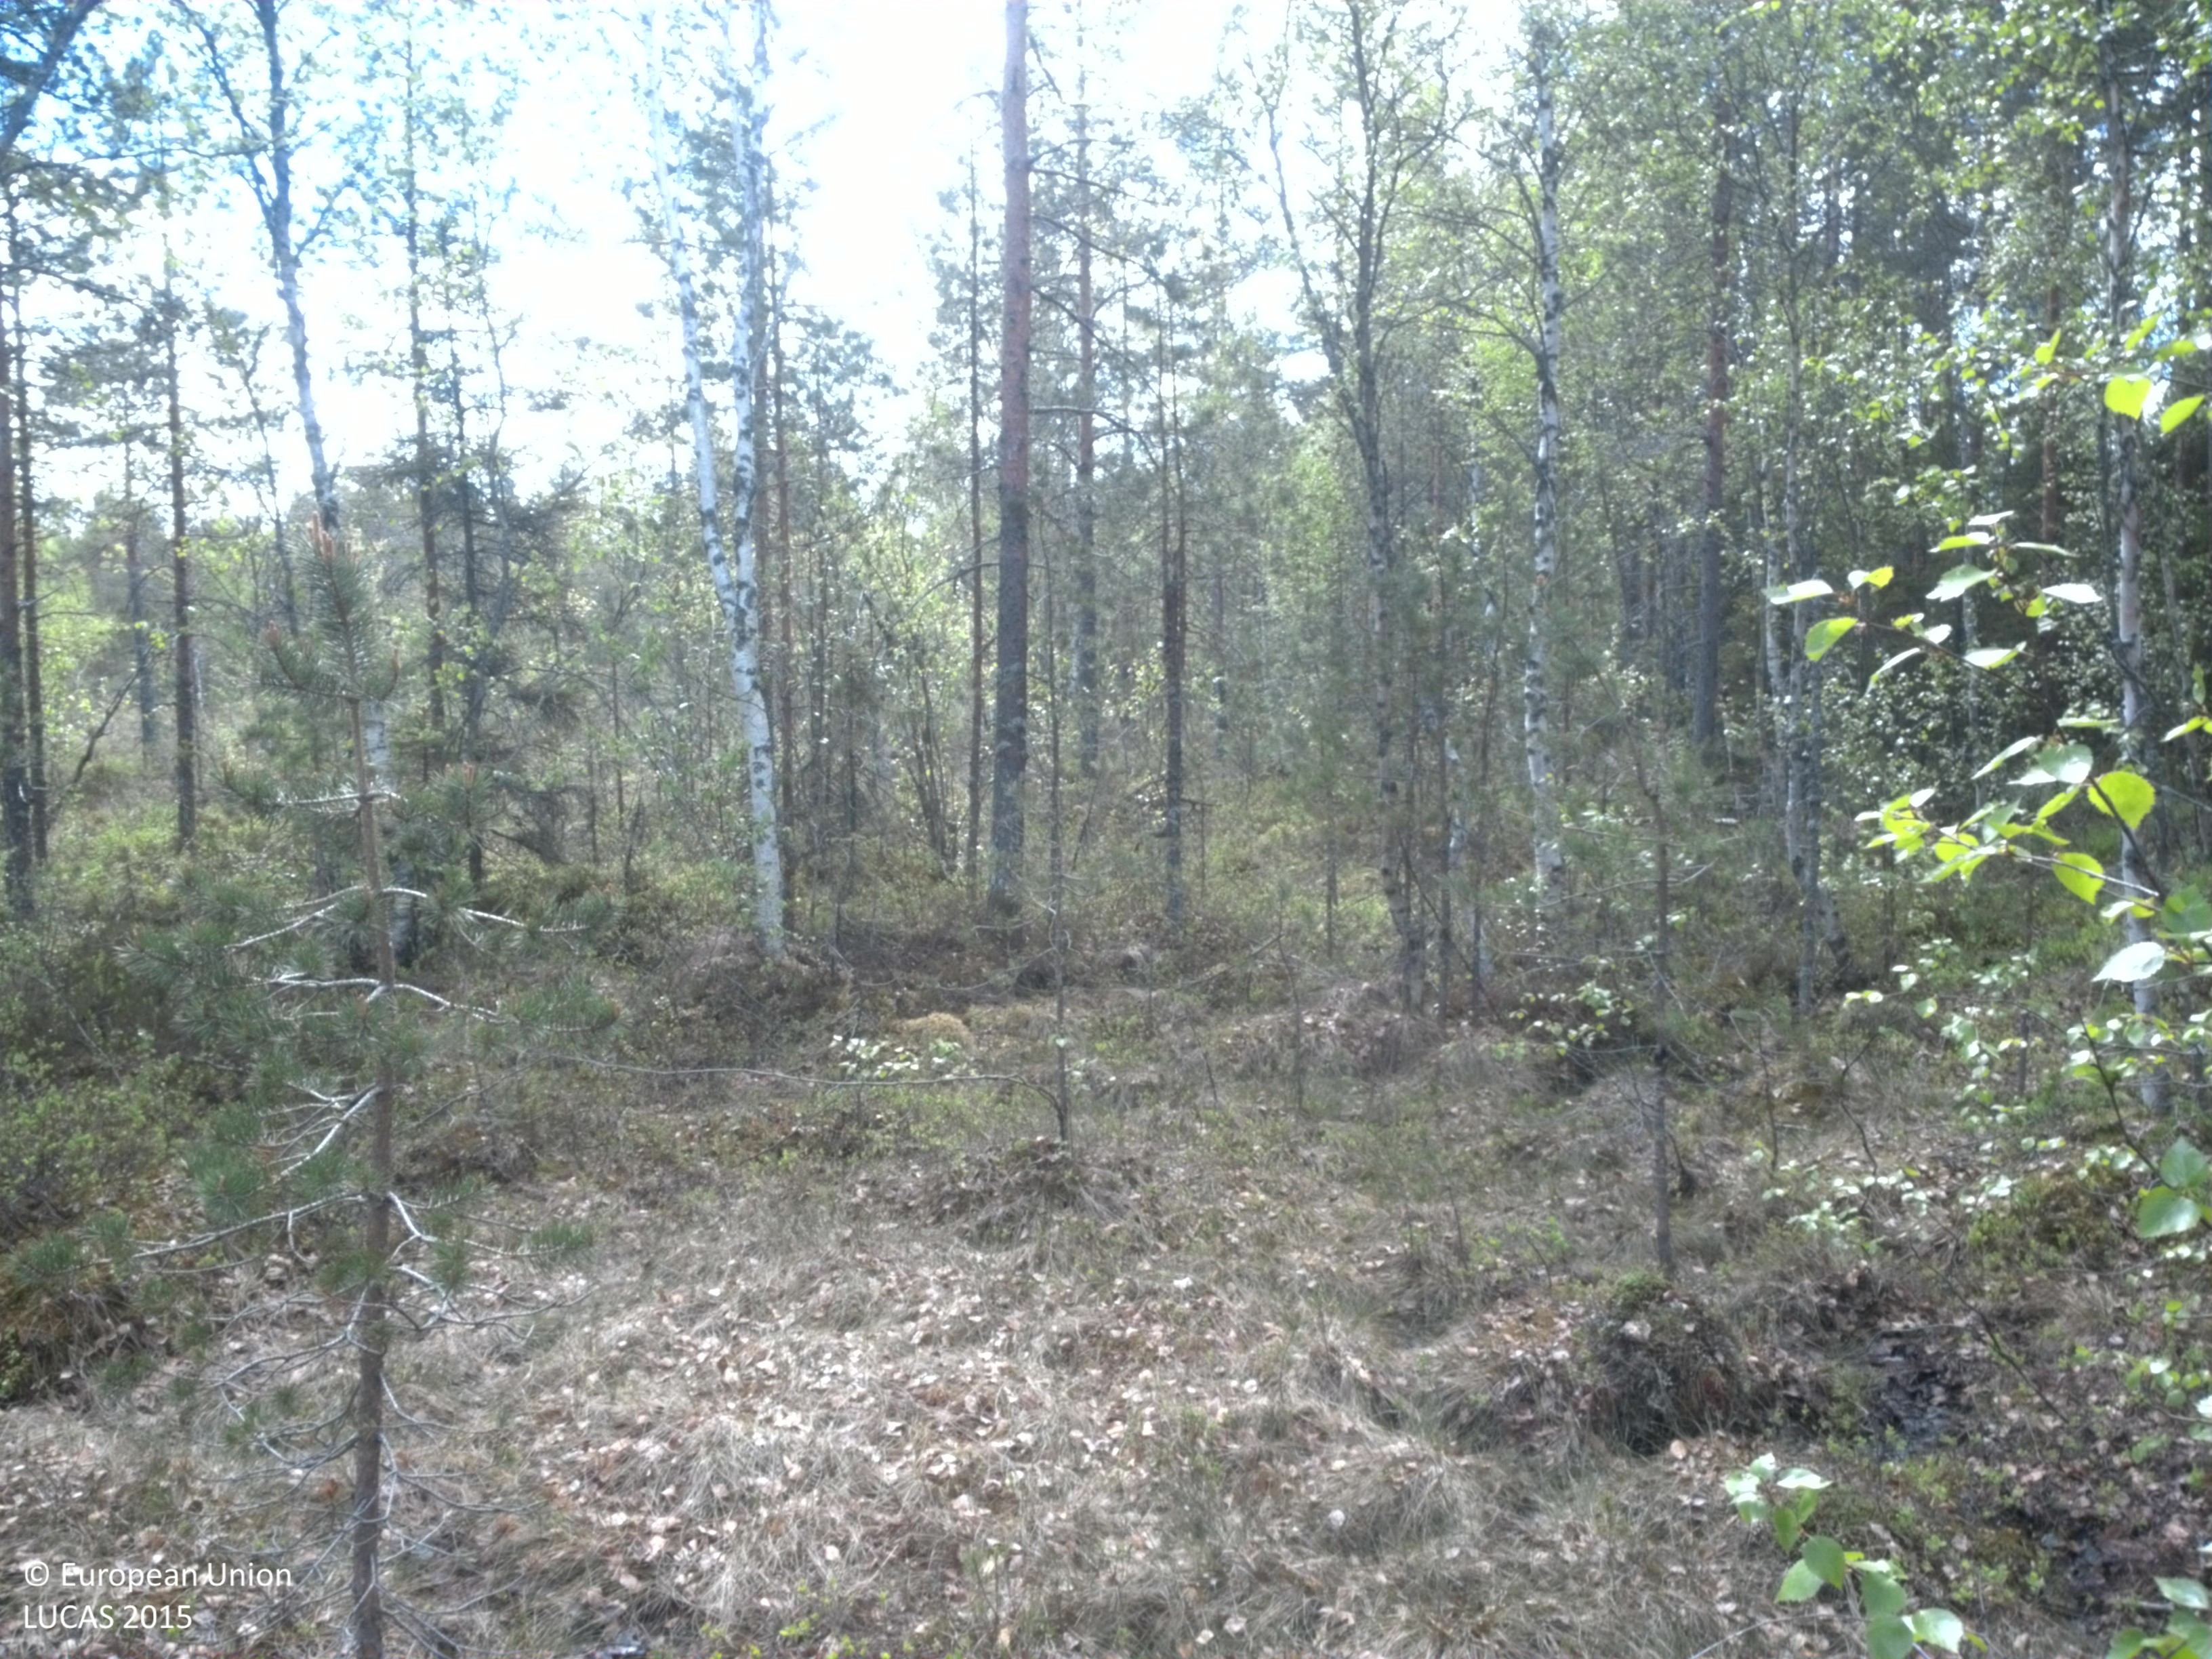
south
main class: Woodland
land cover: Pine dominated mixed woodland
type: mire and swamp forests
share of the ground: 25 - 50 %
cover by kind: shrubs 40 %, coniferous forest trees 30 %, herbaceous plants 15 %, broadleaved forest trees 10 %, lichens and mosses 5 %
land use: Semi-natural and natural areas not in use
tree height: > 5 m
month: June
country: SE
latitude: 63.9555
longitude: 20.5363
